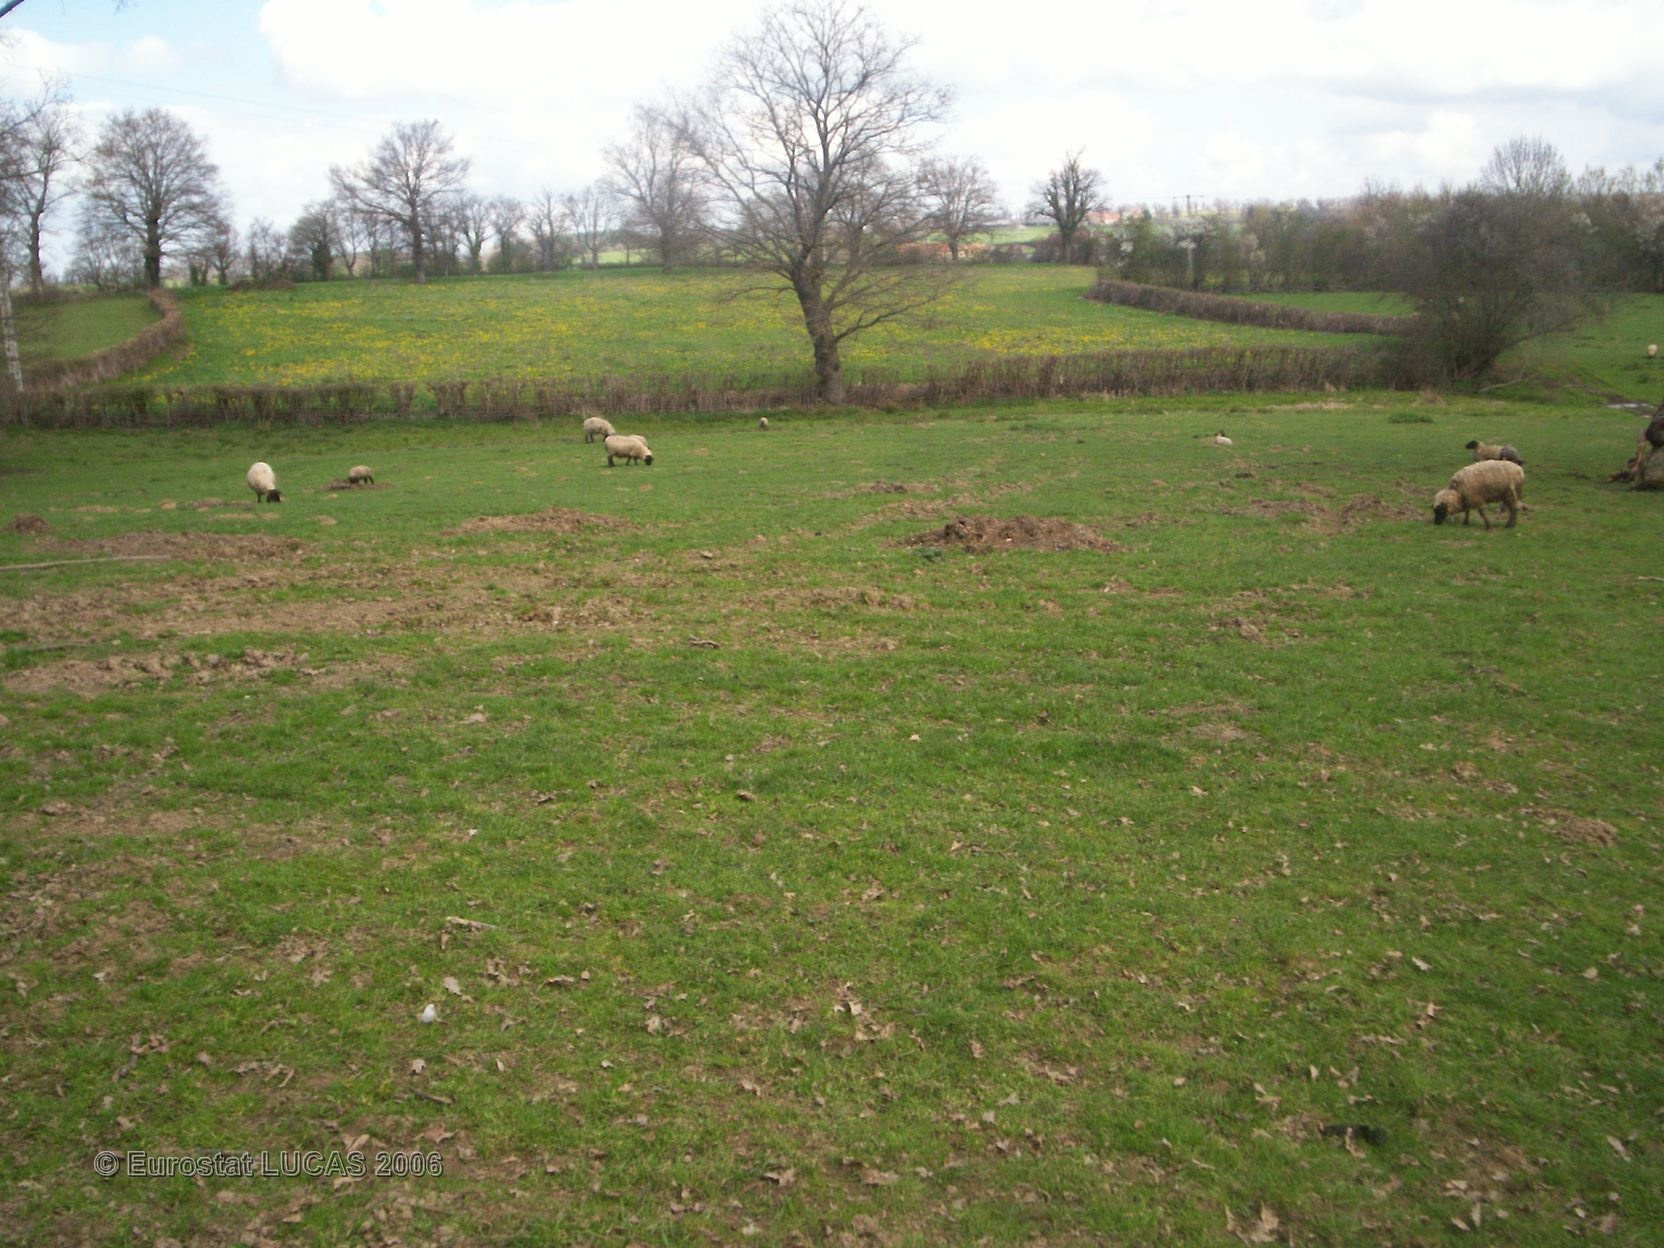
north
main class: Grassland
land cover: Grassland without tree/shrub cover
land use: Agriculture (excluding fallow land and kitchen gardens)
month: April
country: FR
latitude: 46.4117
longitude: 3.0115
